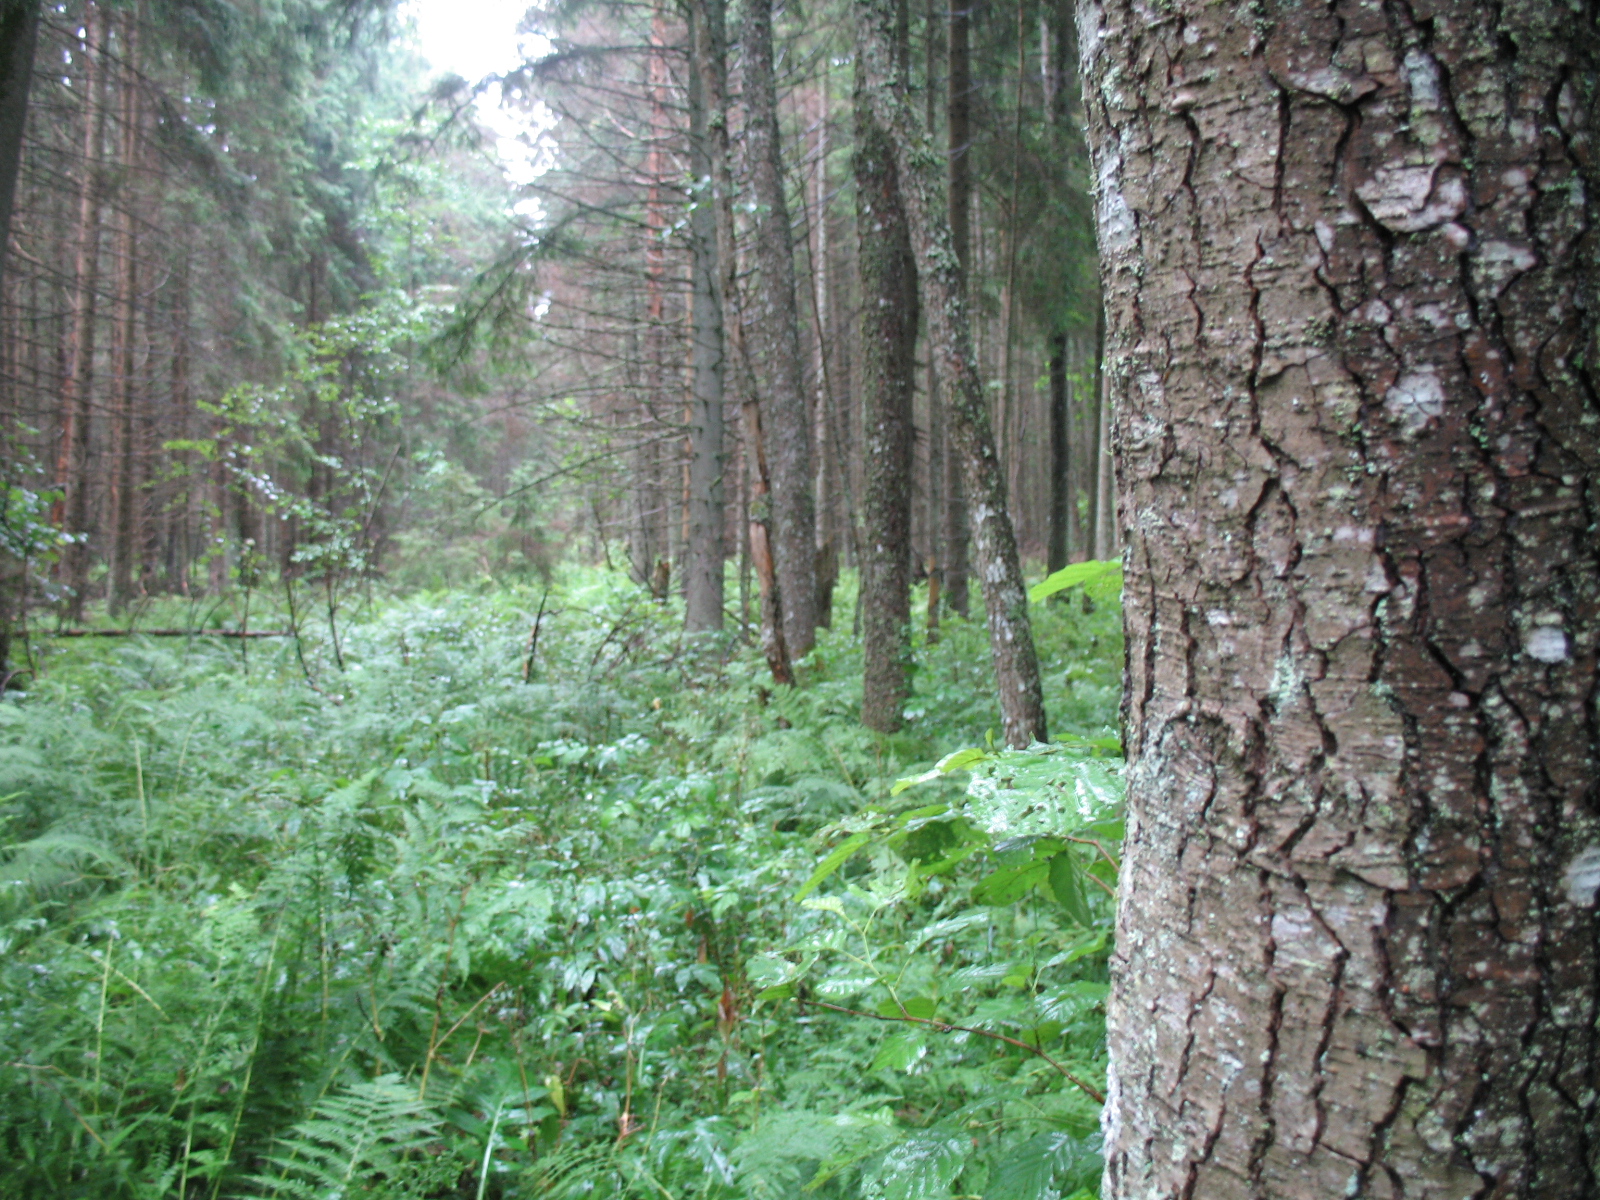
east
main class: Woodland
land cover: Spruce dominated mixed woodland
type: hemiboreal forest and nemoral coniferous forest and mixed broadleaved-coniferous forest
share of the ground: > 75 %
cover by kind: coniferous forest trees 40 %, broadleaved forest trees 40 %, herbaceous plants 20 %
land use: Forestry
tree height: > 5 m
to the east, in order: Spruce dominated mixed woodland; Ditches and canals; Spruce dominated coniferous woodland; Spruce dominated mixed woodland; Other coniferous woodland
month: July
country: LV
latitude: 56.4576
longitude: 25.1209
